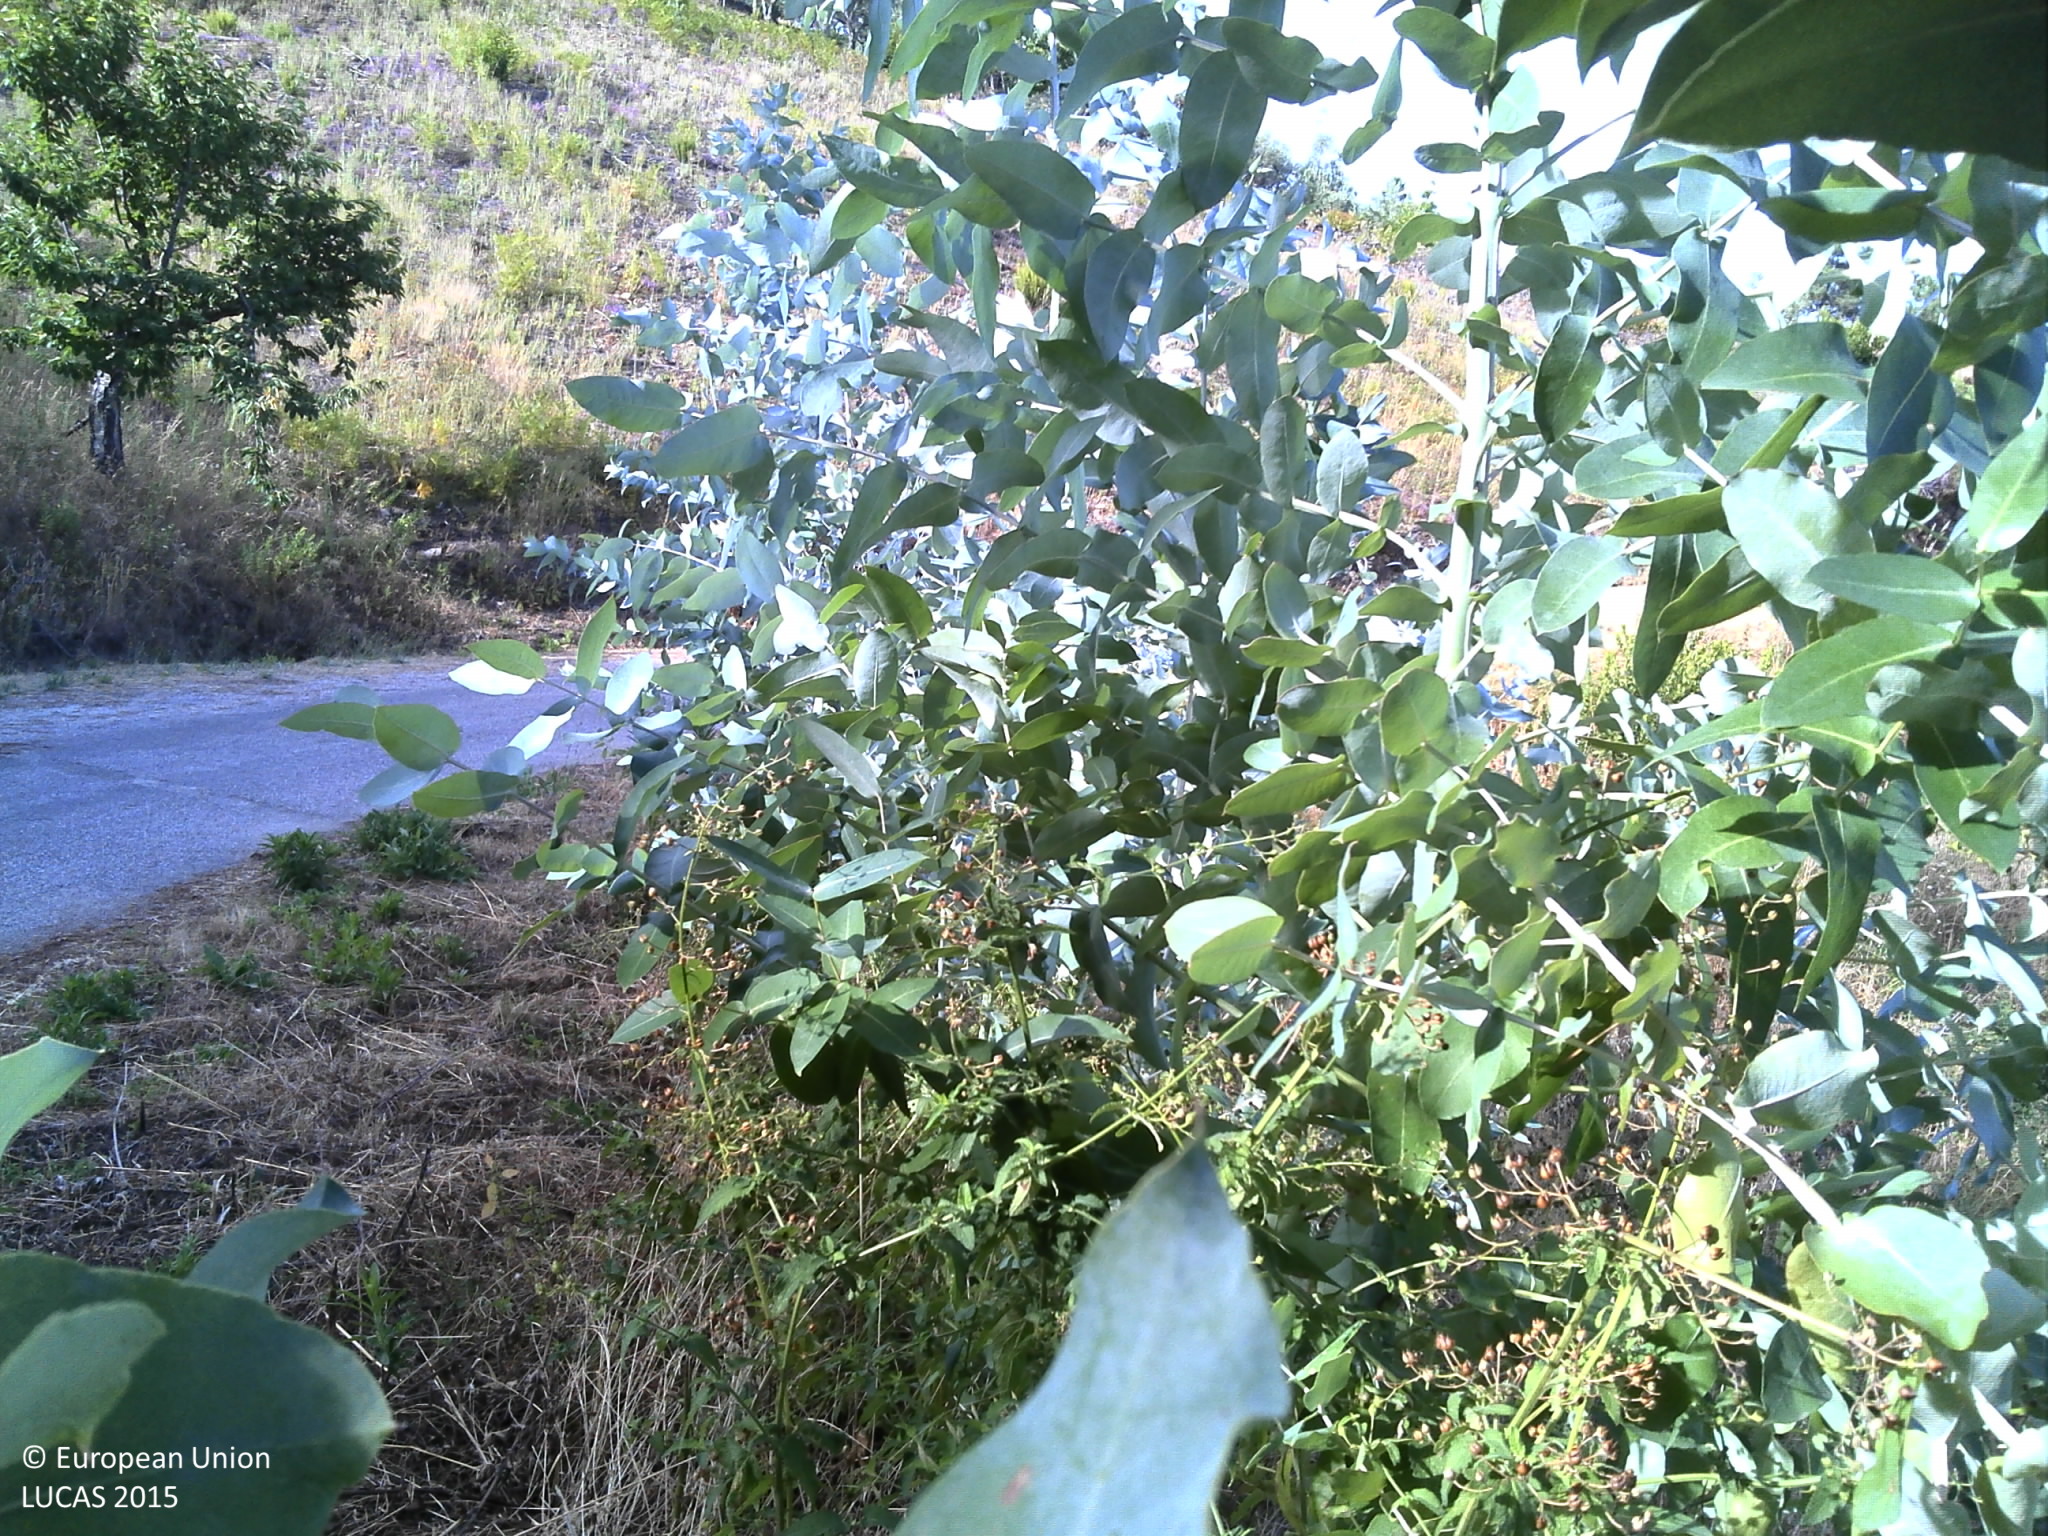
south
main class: Woodland
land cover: Broadleaved woodland
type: exotic forest
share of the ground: < 10 %
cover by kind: shrubs 90 %, broadleaved forest trees 10 %
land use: Forestry
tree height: < 5 m
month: July
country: PT
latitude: 39.8253
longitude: -7.9994
